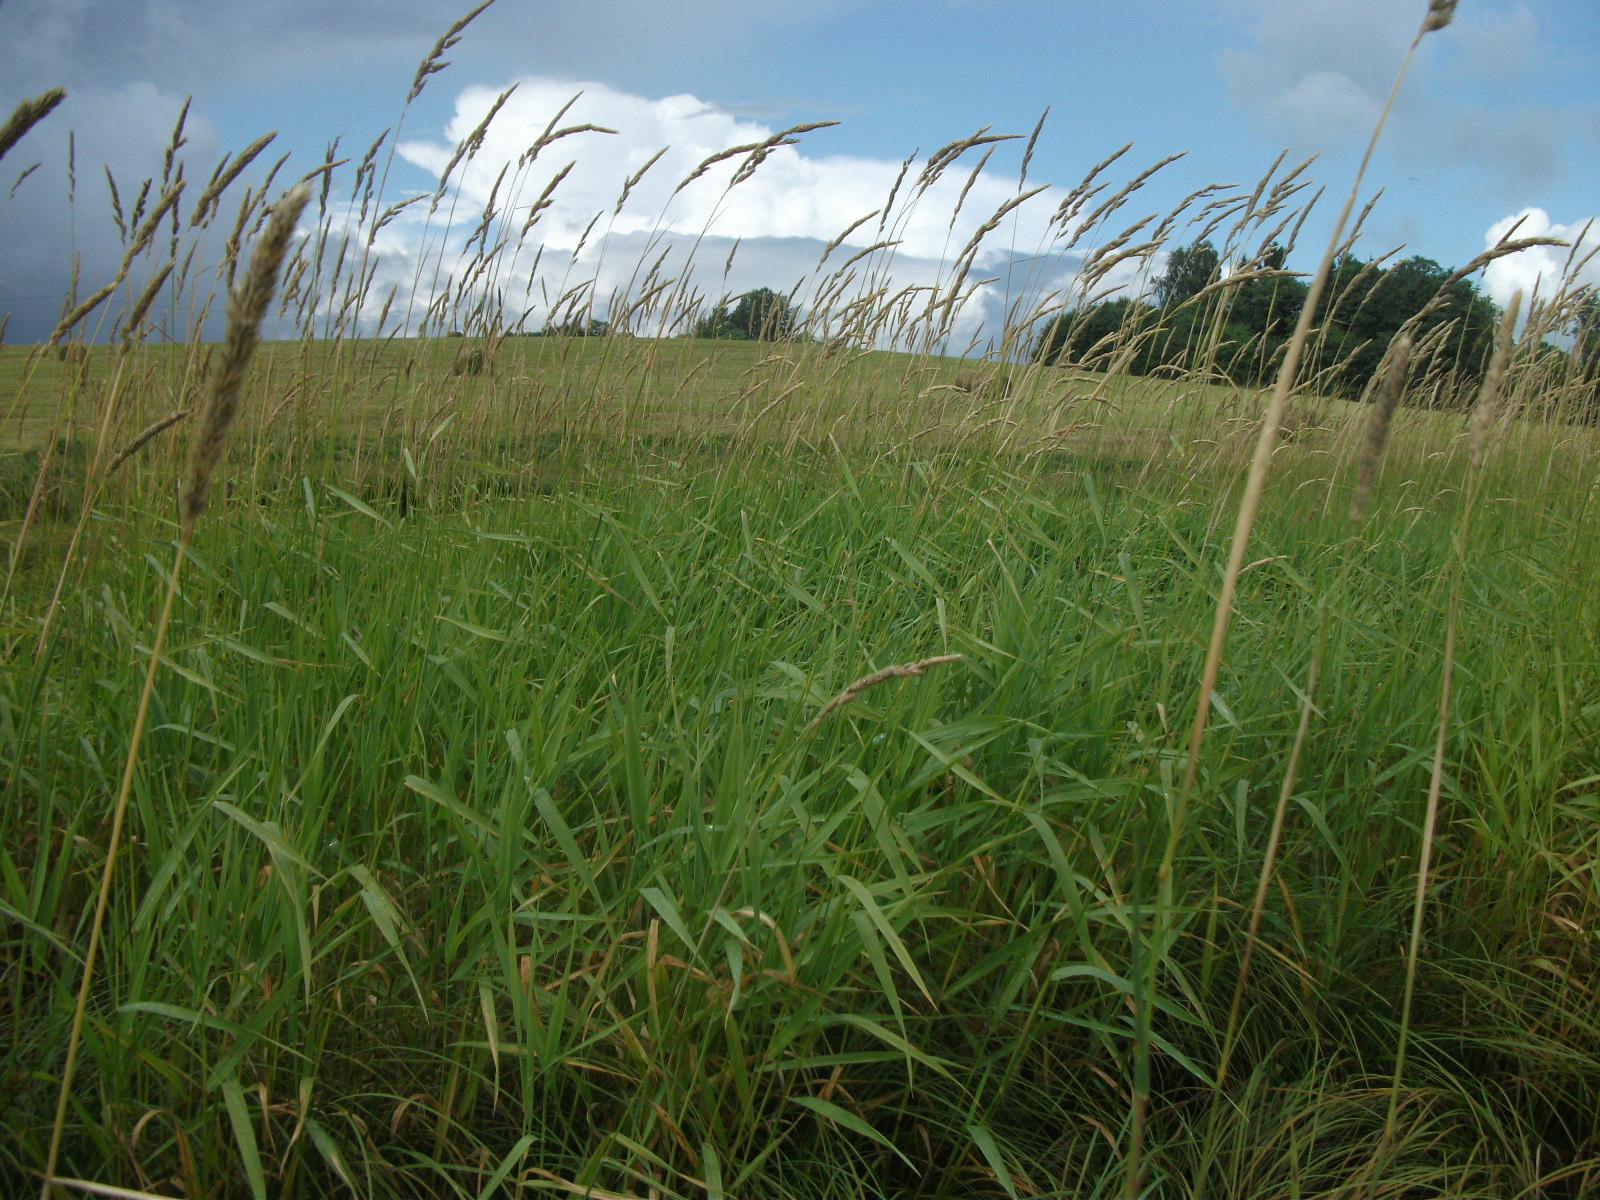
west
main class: Grassland
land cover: Grassland without tree/shrub cover
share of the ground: > 75 %
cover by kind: herbaceous plants 100 %
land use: Agriculture (excluding fallow land and kitchen gardens)
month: July
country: LV
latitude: 57.0078
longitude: 25.8860
